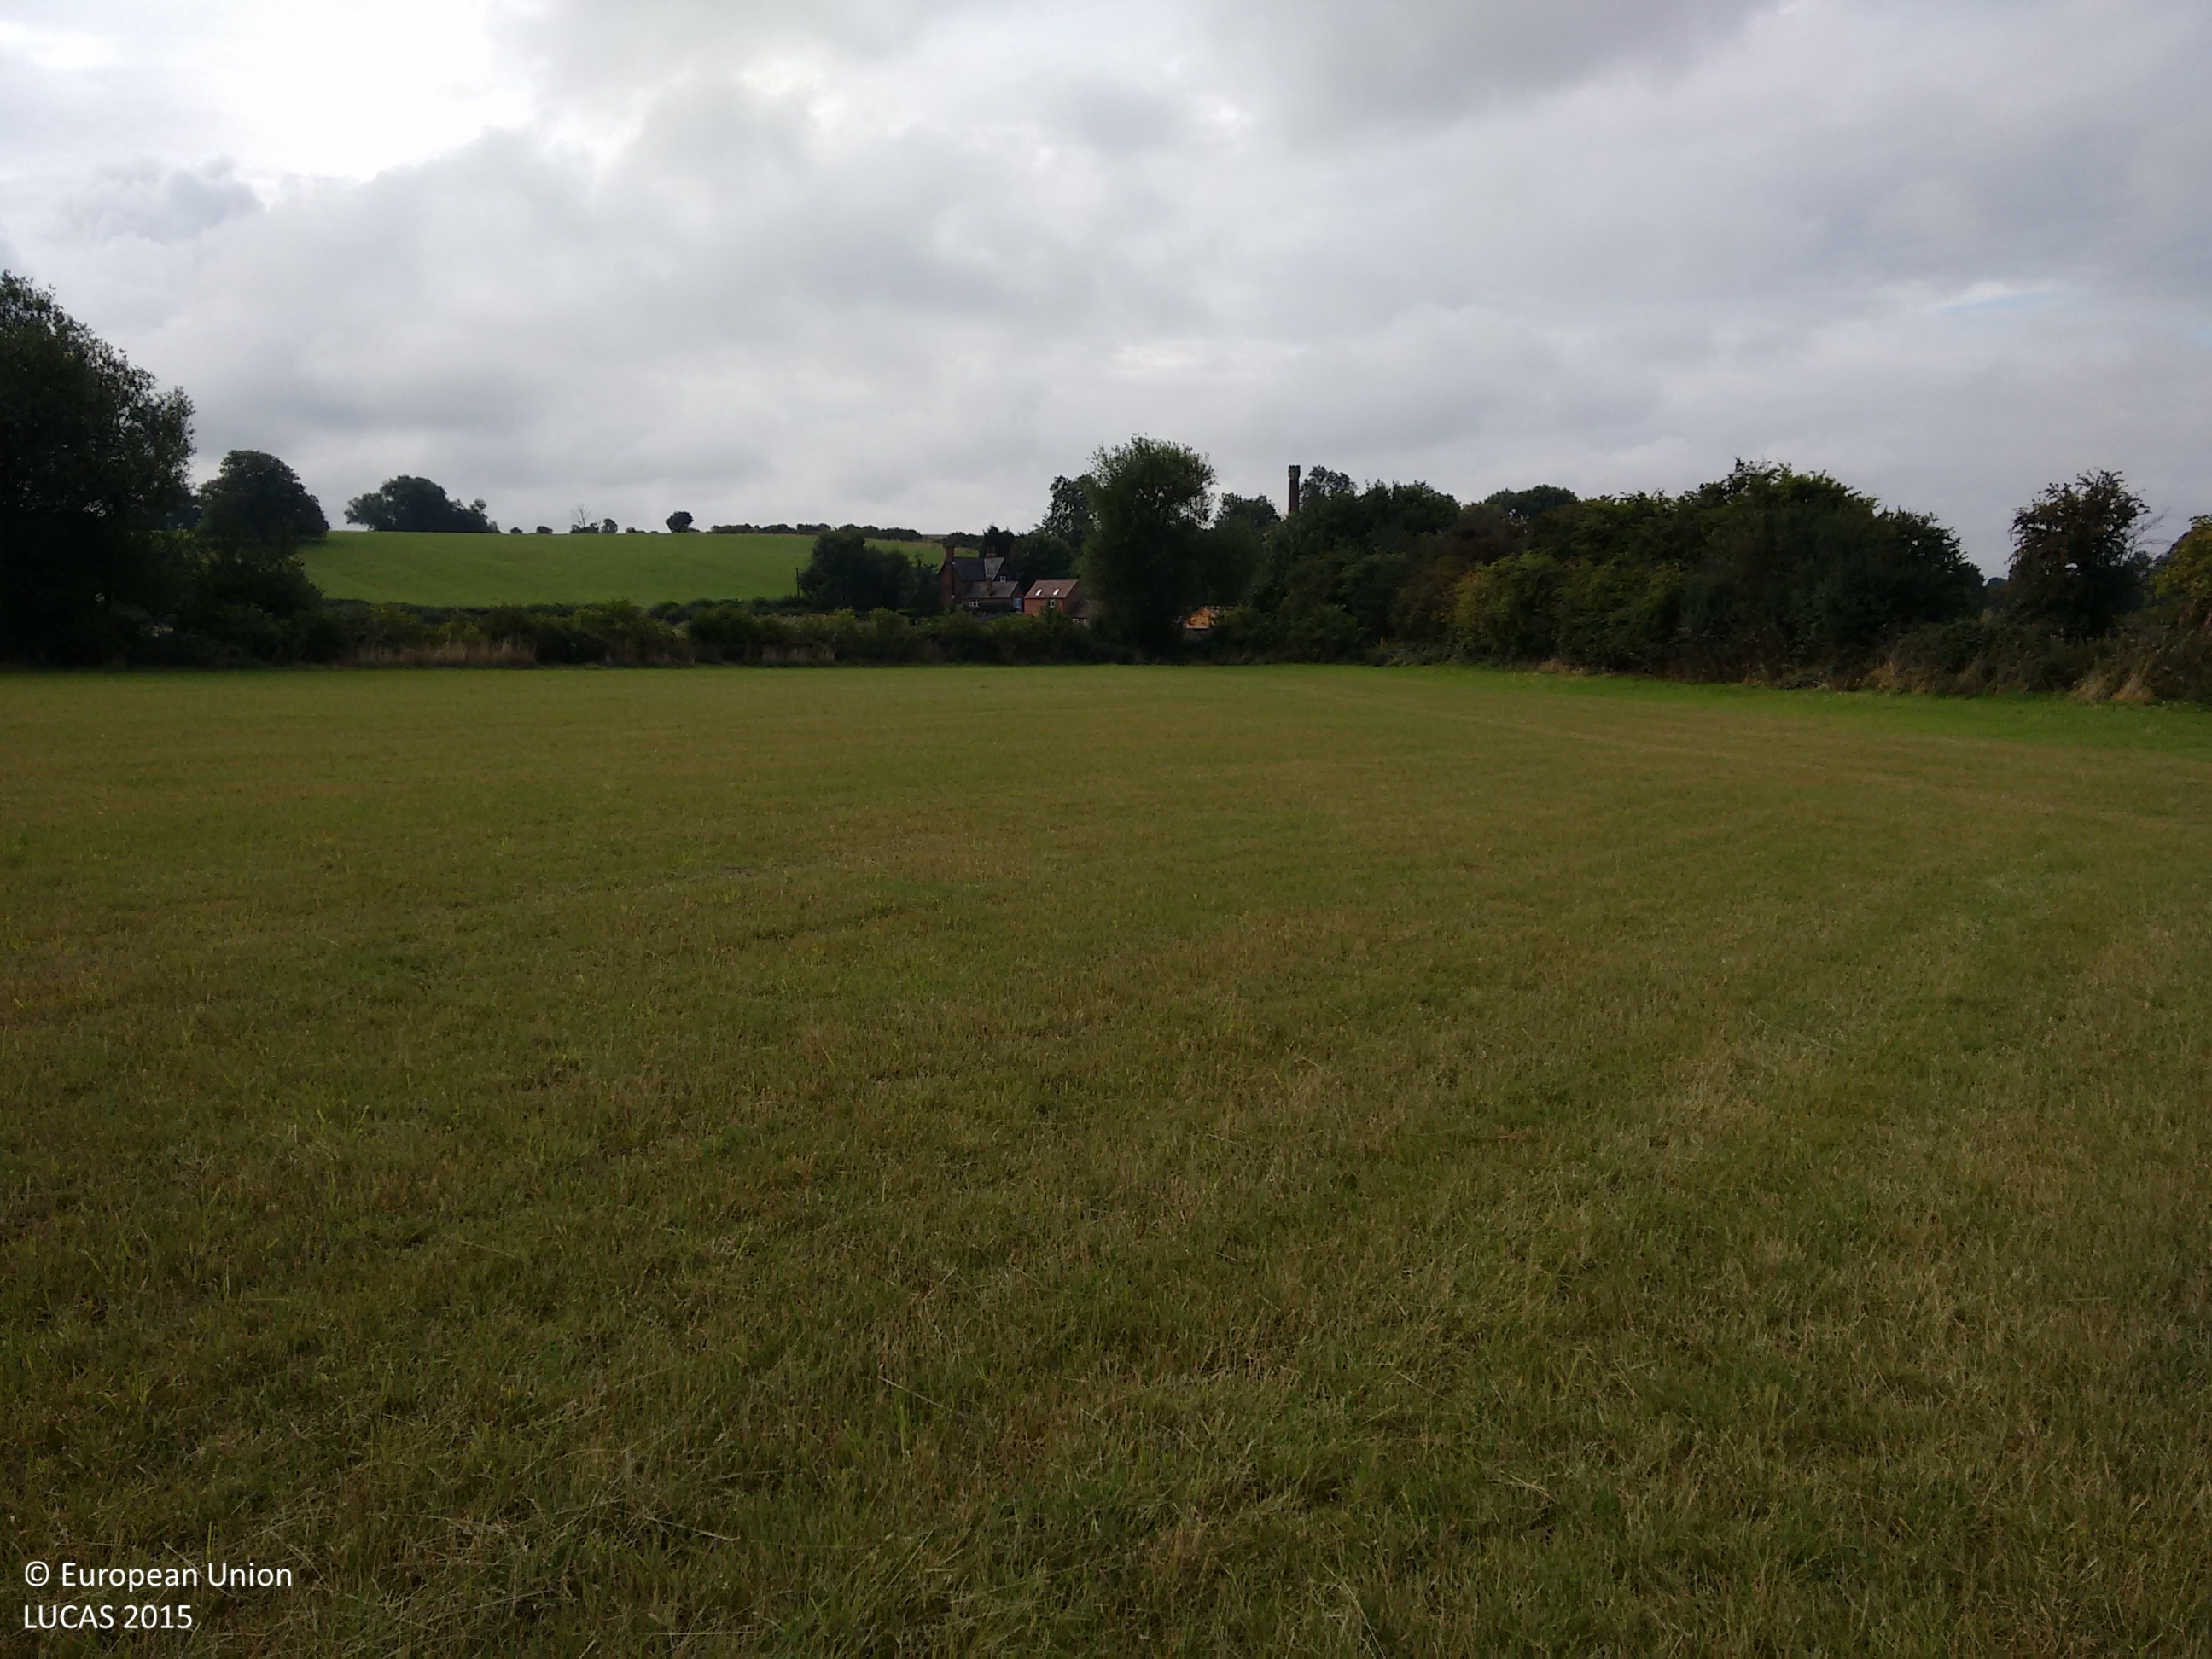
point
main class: Grassland
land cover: Grassland without tree/shrub cover
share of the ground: > 75 %
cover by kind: herbaceous plants 100 %
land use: Agriculture (excluding fallow land and kitchen gardens)
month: September
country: GB
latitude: 52.6897
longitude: -1.4869
